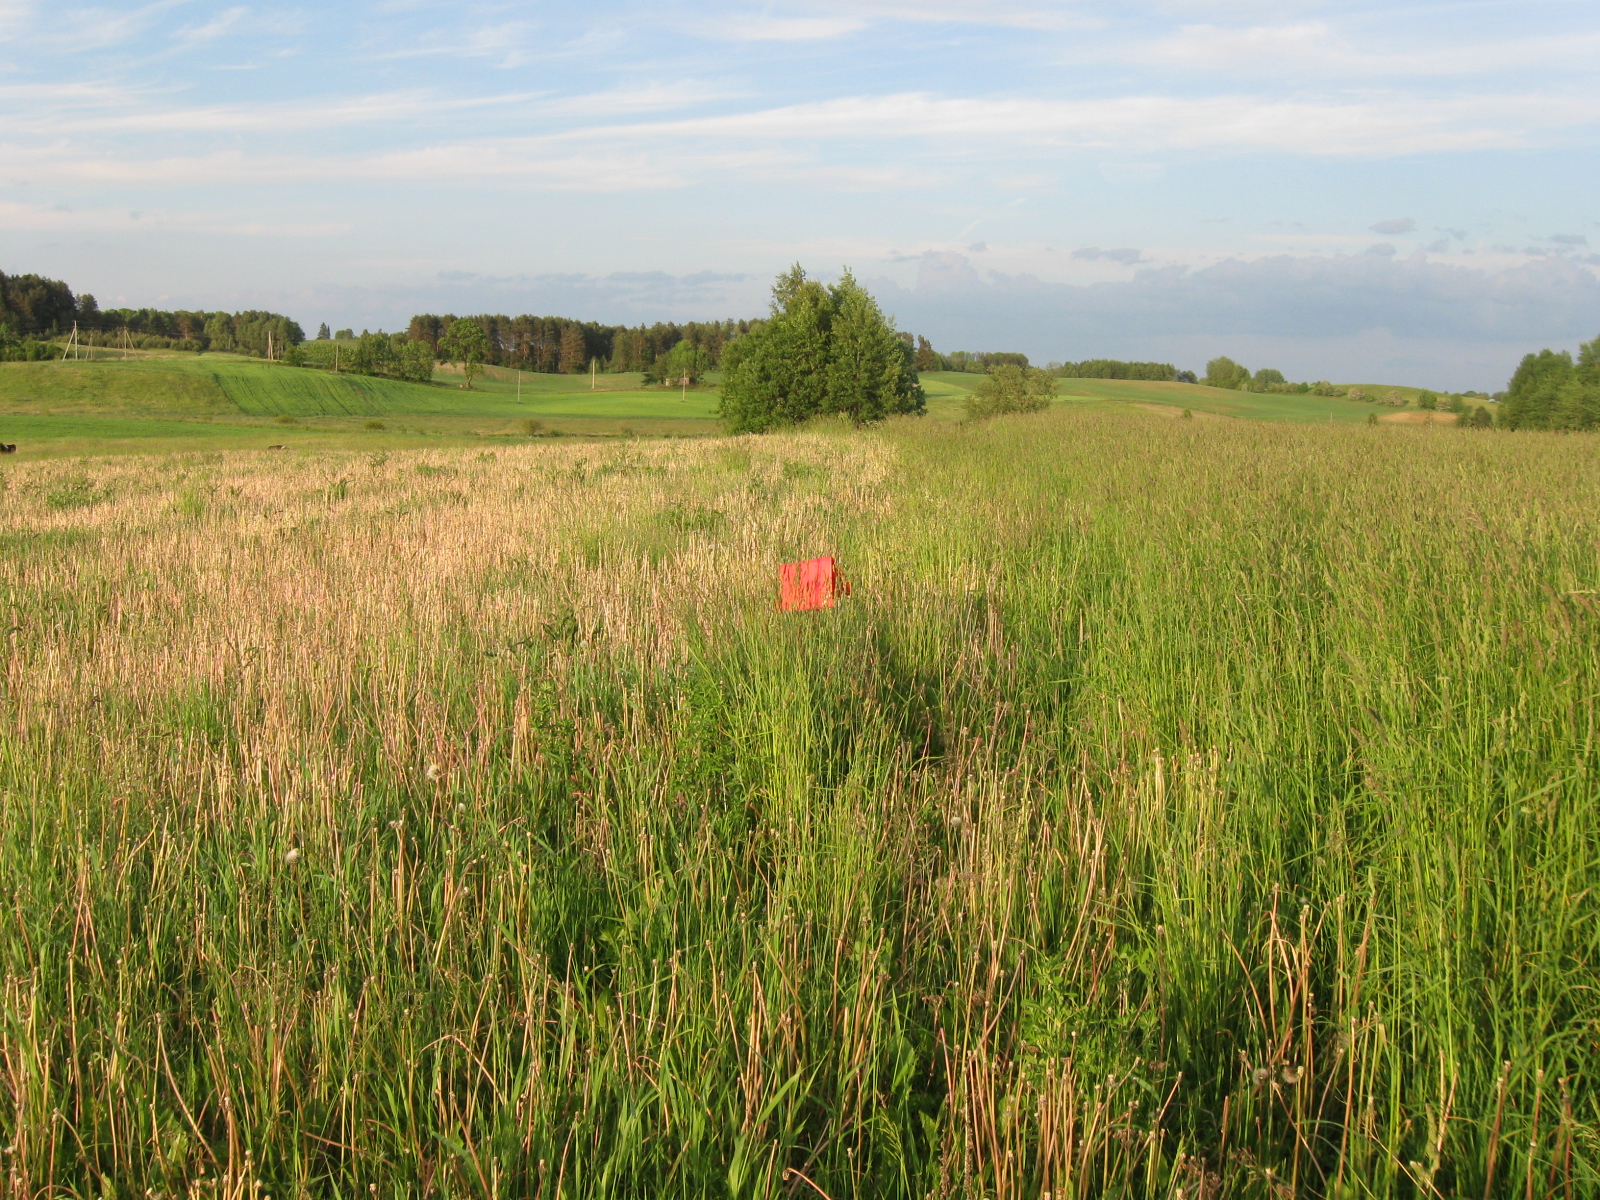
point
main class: Grassland
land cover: Grassland without tree/shrub cover
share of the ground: > 75 %
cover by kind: herbaceous plants 100 %
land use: Agriculture (excluding fallow land and kitchen gardens)
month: June
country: LT
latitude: 54.2533
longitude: 23.6070
